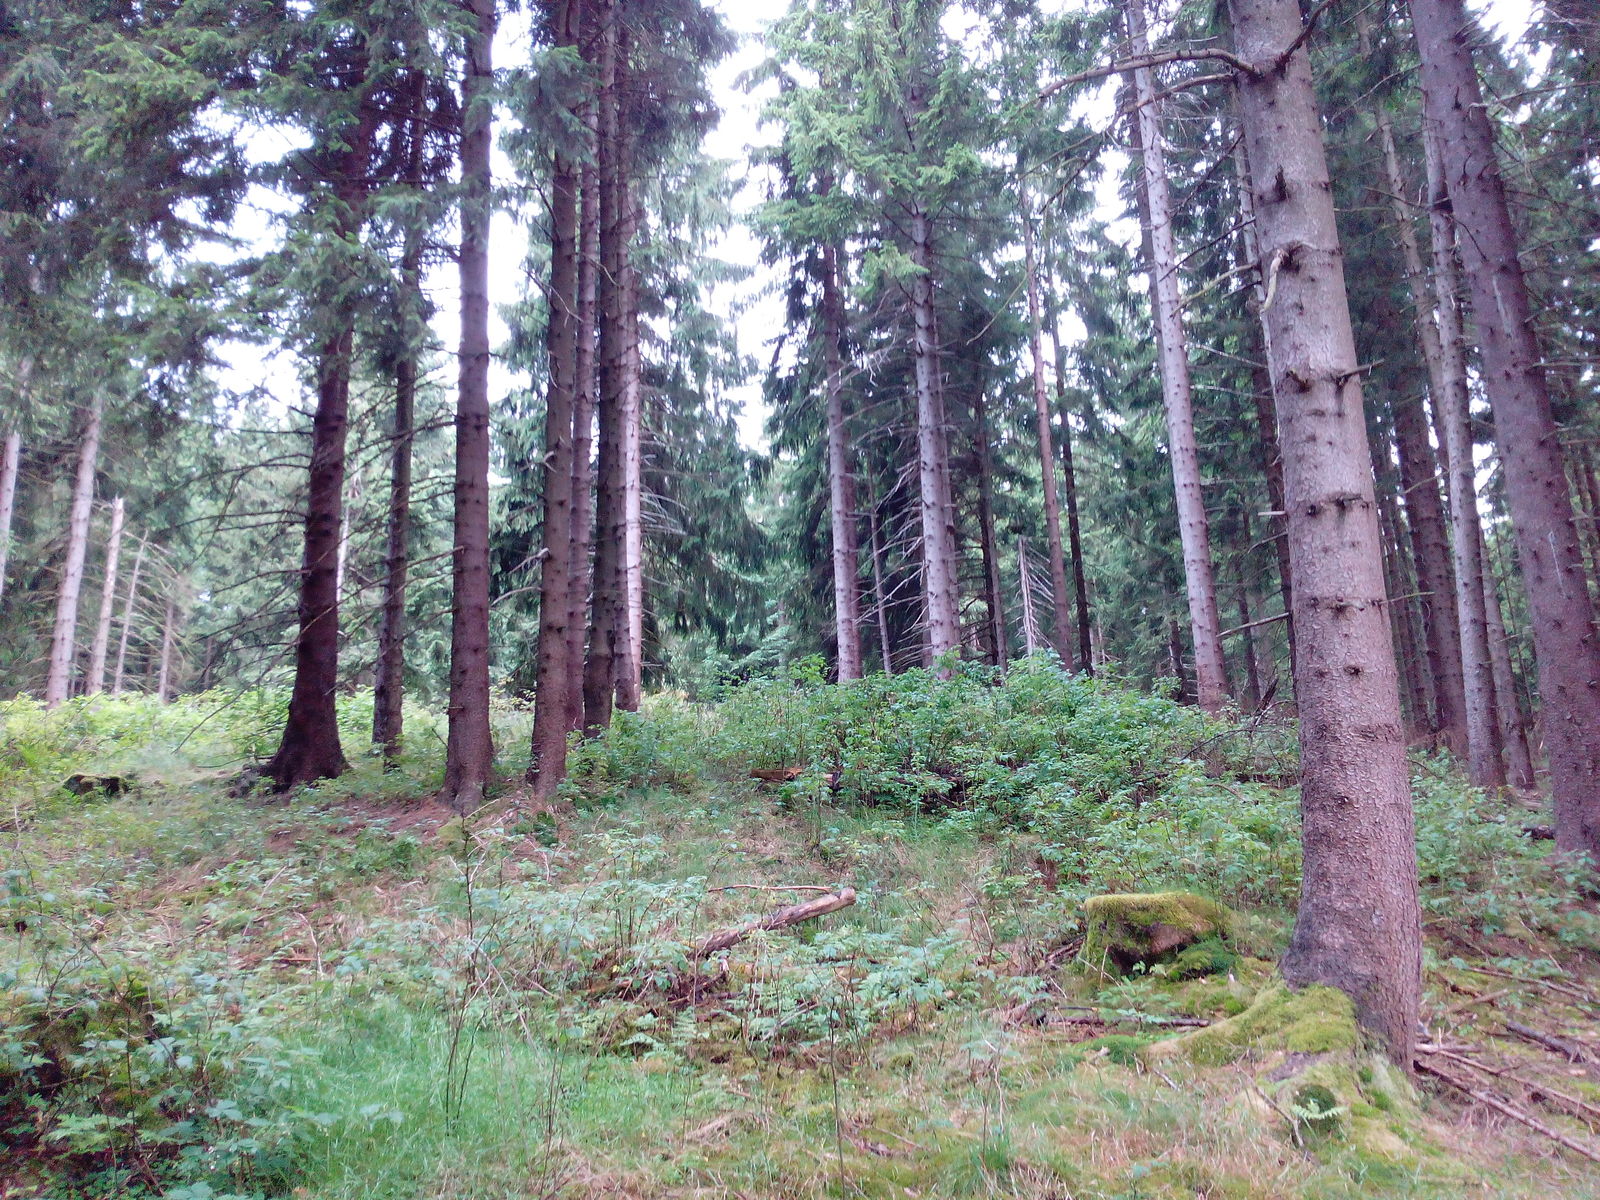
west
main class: Woodland
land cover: Spruce dominated coniferous woodland
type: hemiboreal forest and nemoral coniferous forest and mixed broadleaved-coniferous forest
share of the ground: > 75 %
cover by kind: coniferous forest trees 85 %, herbaceous plants 10 %, shrubs 5 %
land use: Forestry
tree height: > 5 m
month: July
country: DE
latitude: 50.6298
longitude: 10.9469
